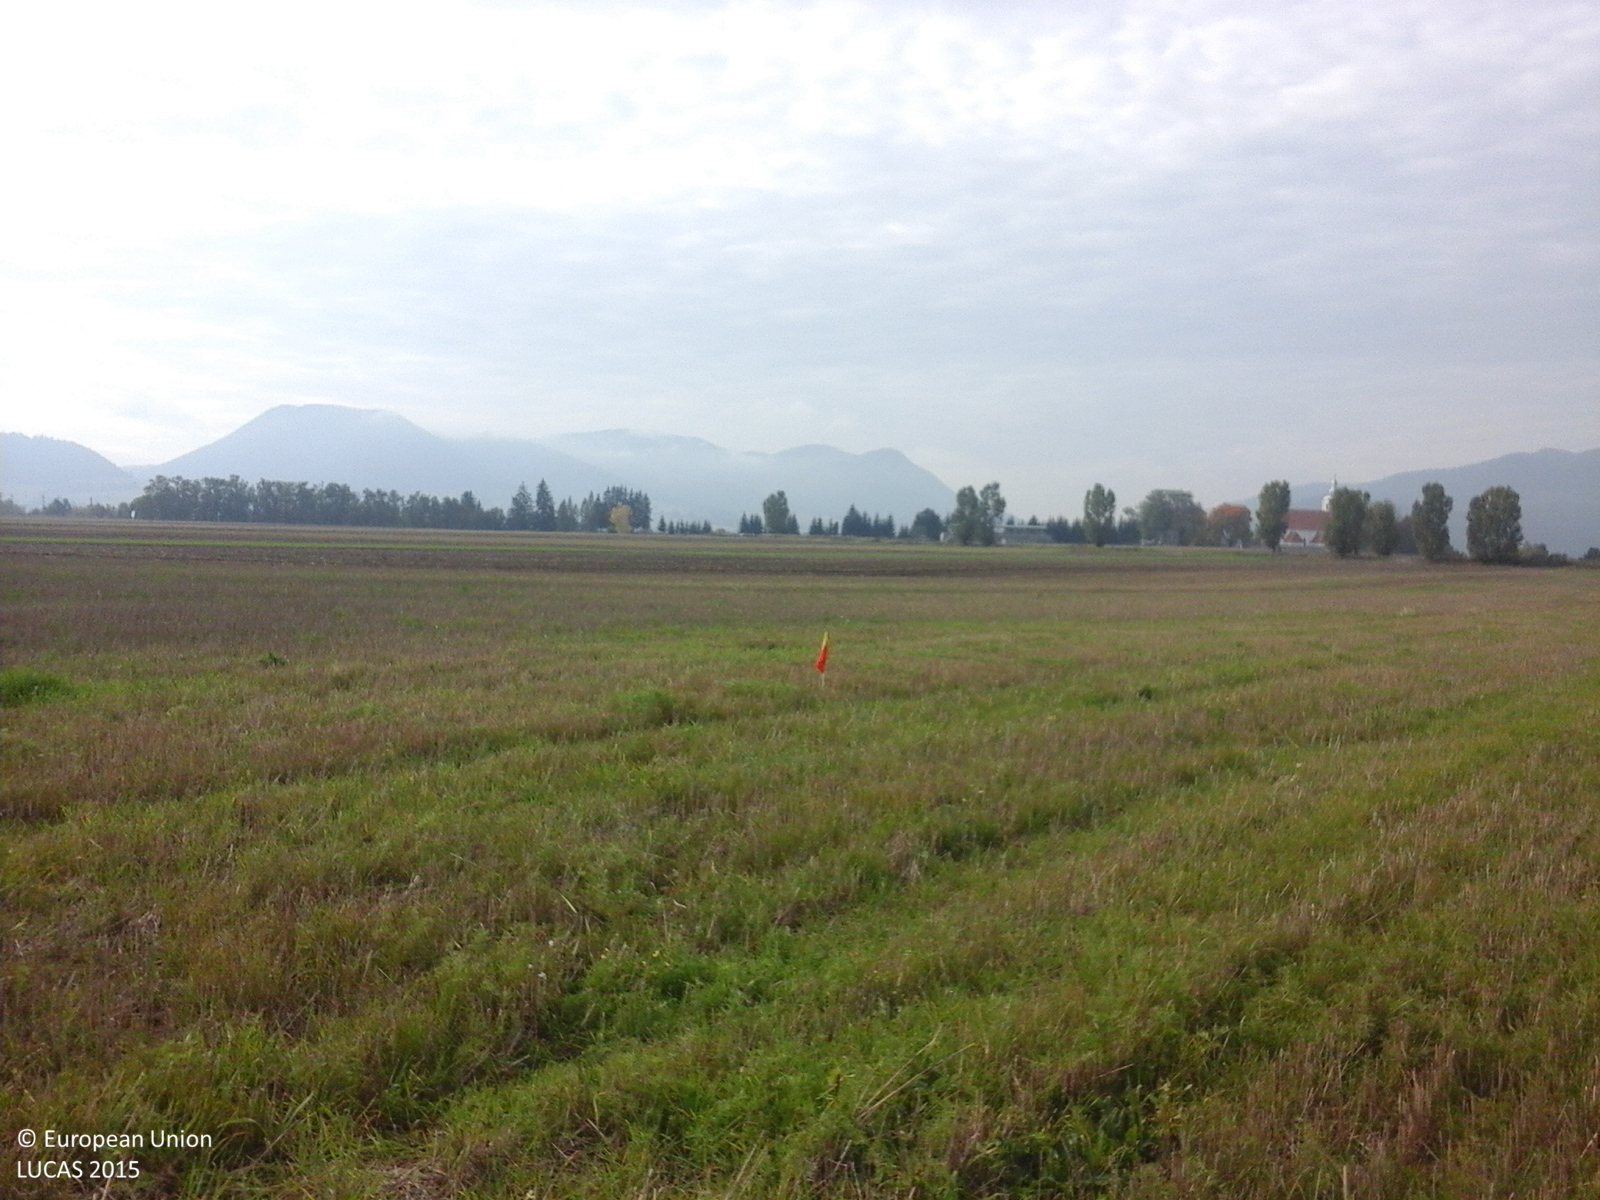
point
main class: Cropland
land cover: Common wheat
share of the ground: > 75 %
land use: Agriculture (excluding fallow land and kitchen gardens)
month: October
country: RO
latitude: 46.2135
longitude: 25.9179
